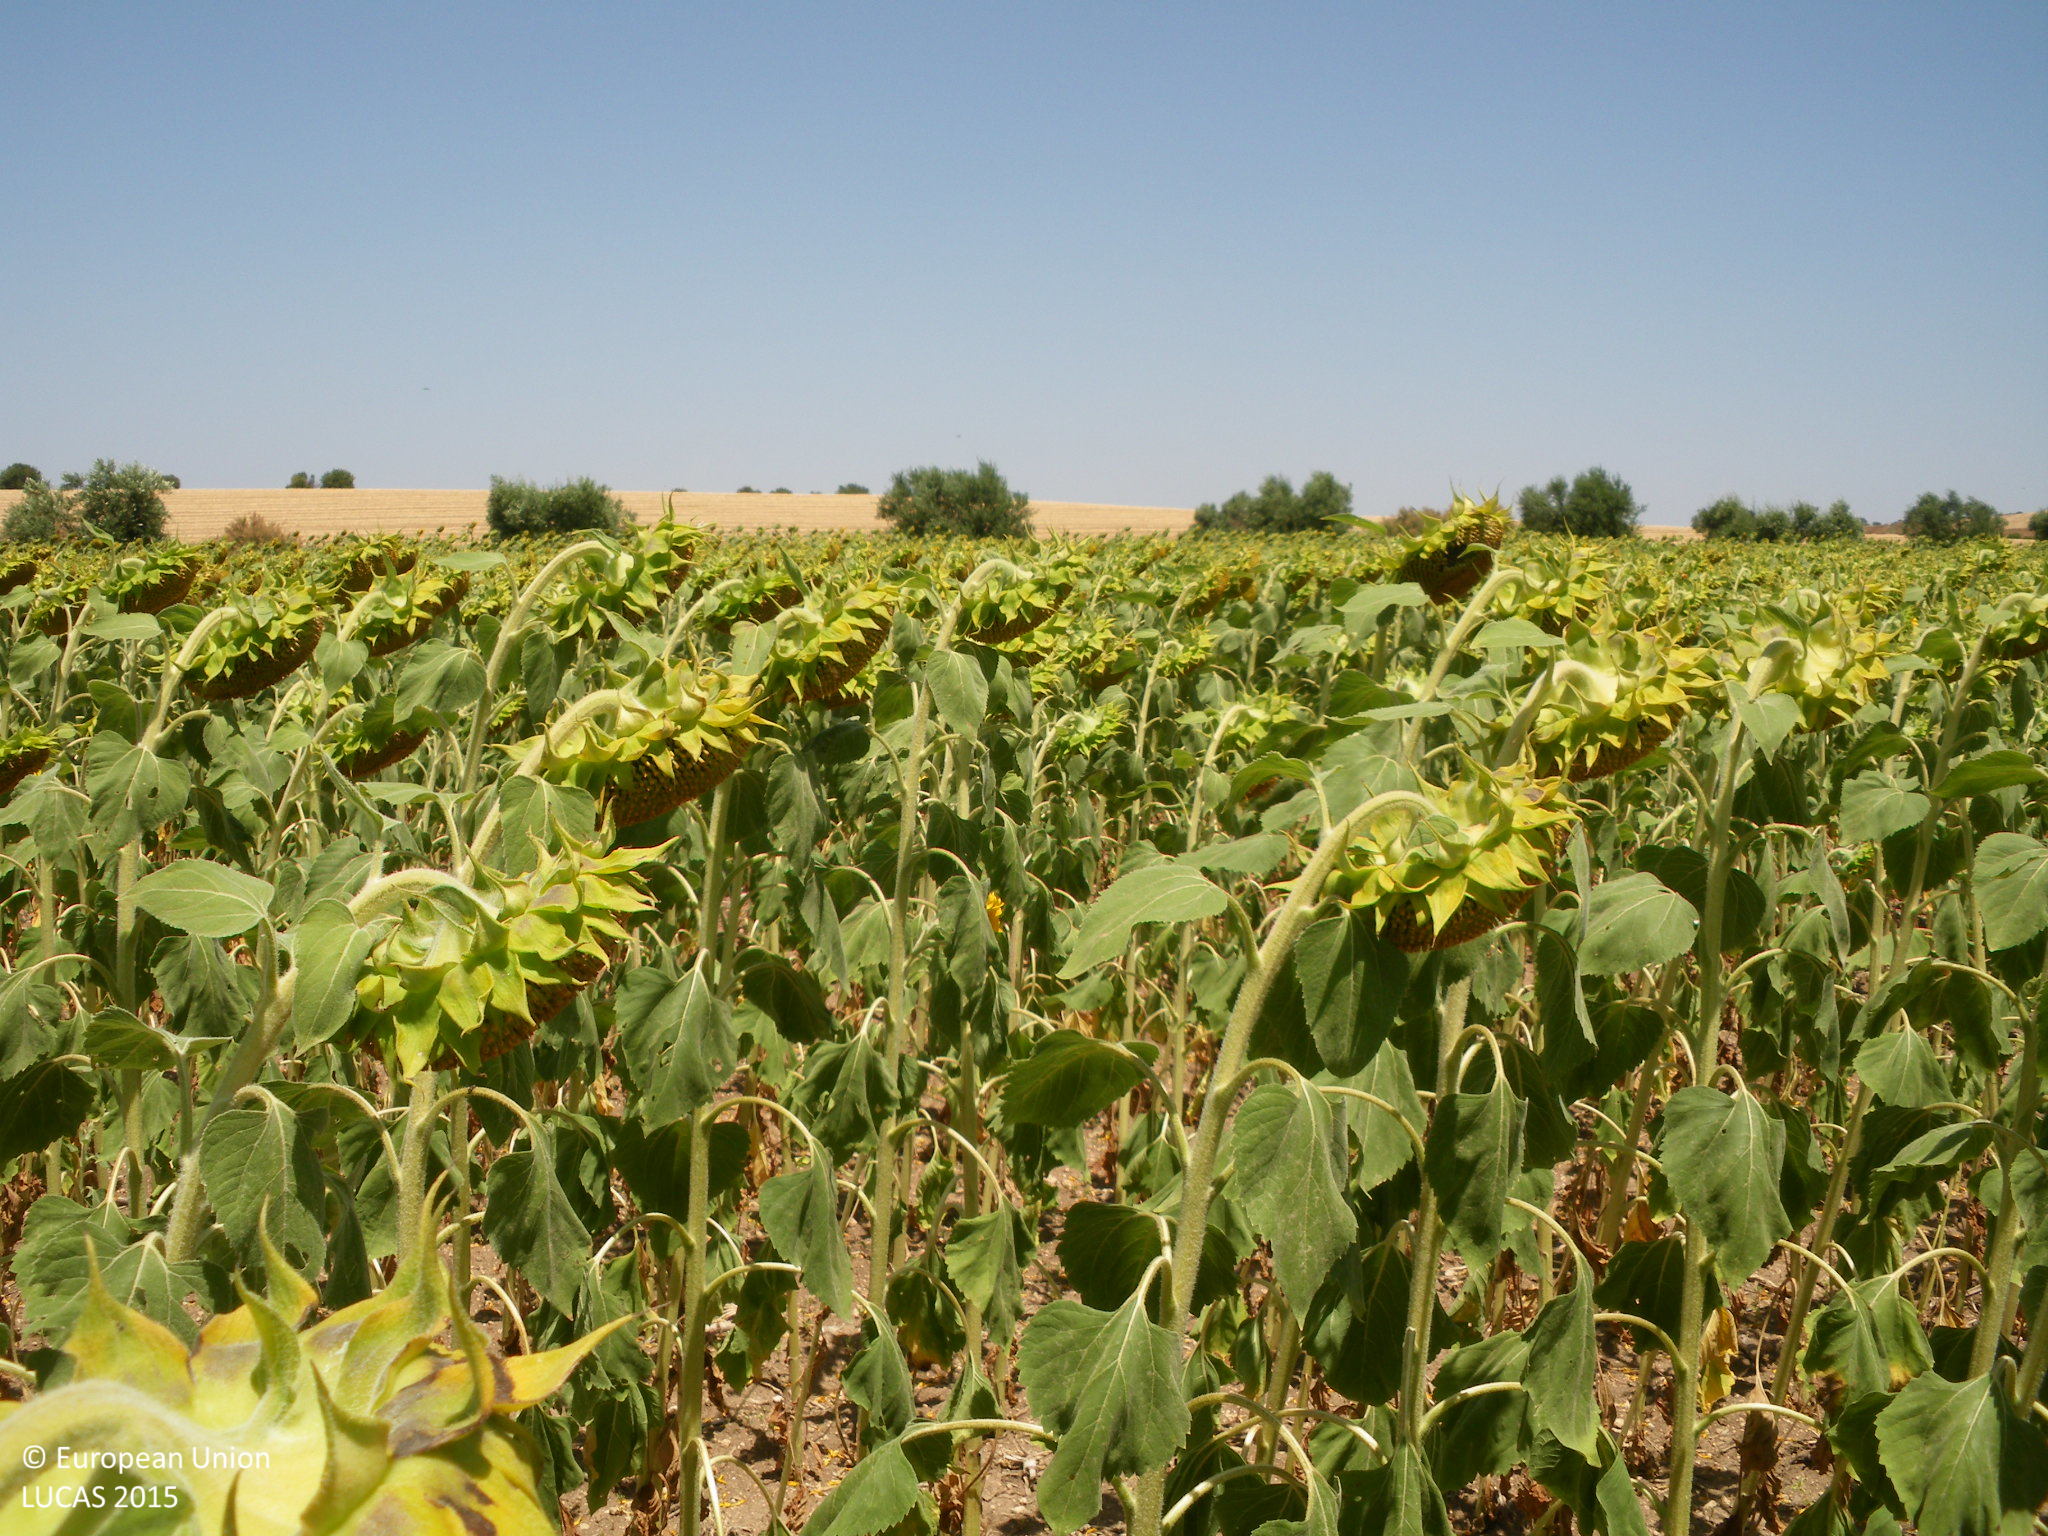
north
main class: Cropland
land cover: Sunflower
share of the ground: > 75 %
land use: Agriculture (excluding fallow land and kitchen gardens)
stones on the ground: < 10 %
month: June
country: ES
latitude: 36.8240
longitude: -6.0114
